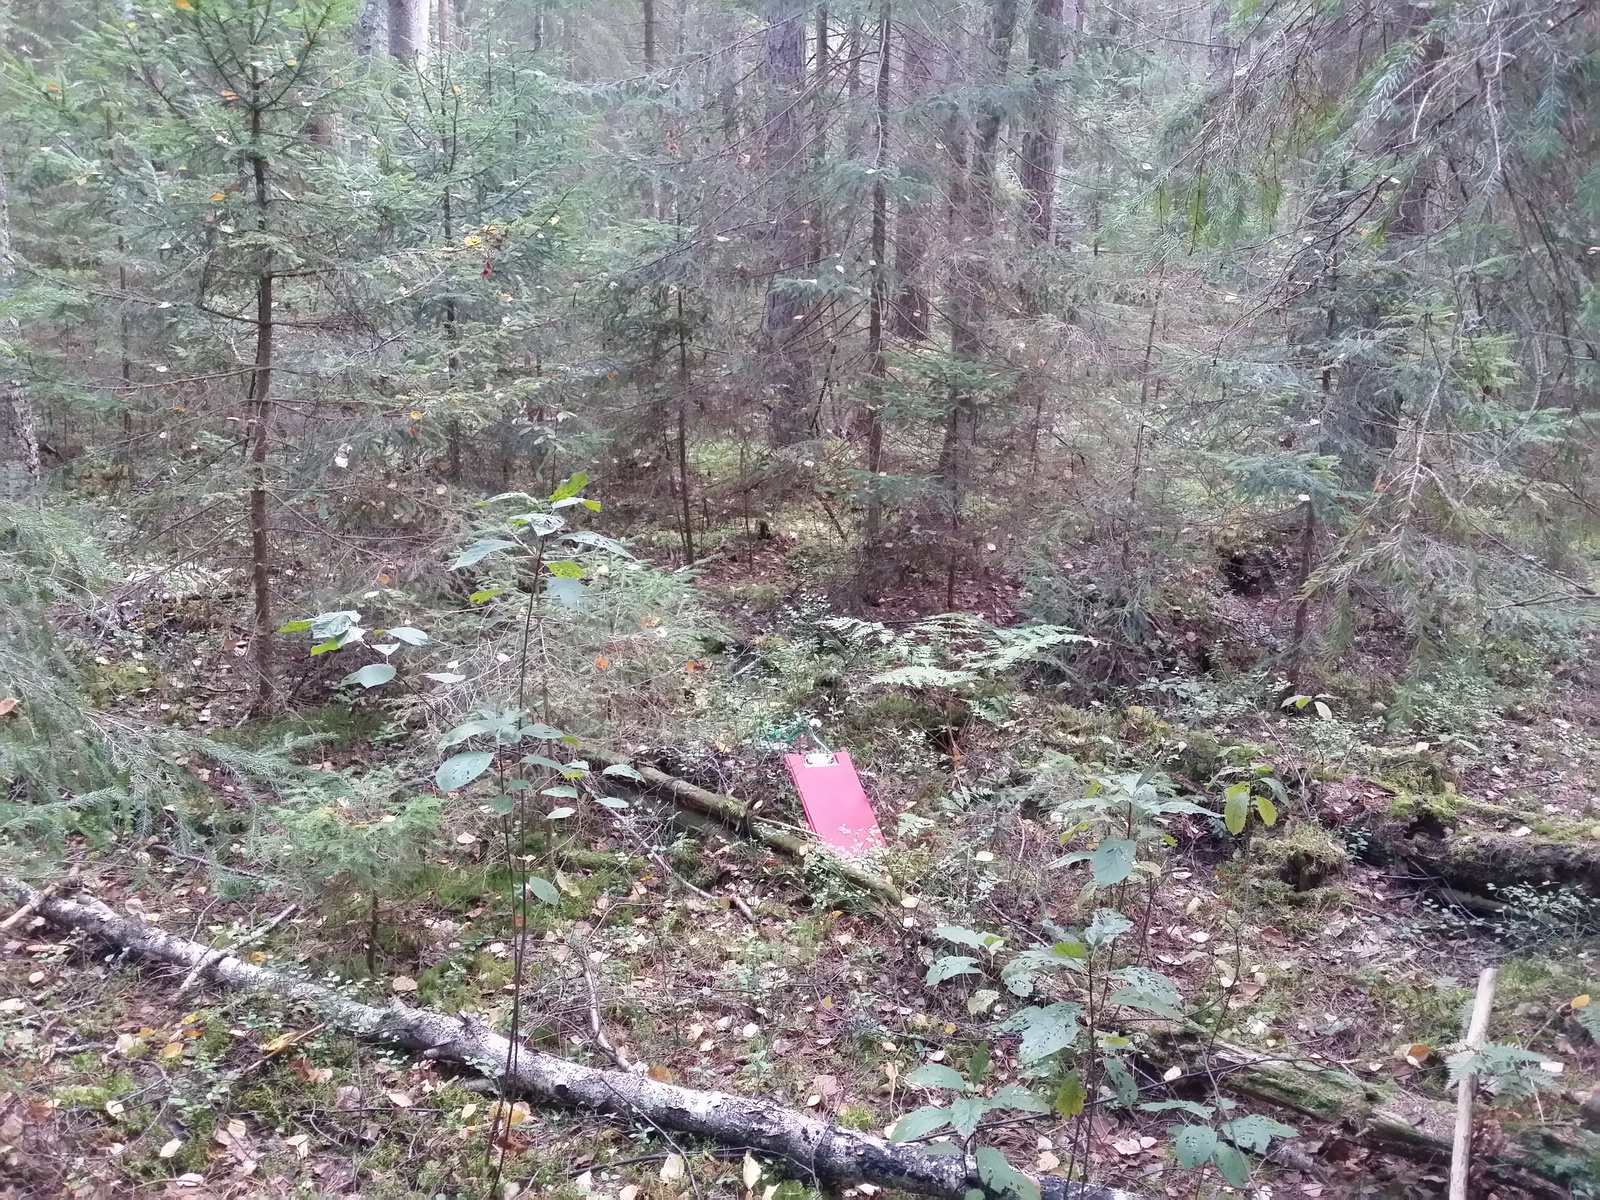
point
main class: Woodland
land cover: Spruce dominated coniferous woodland
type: hemiboreal forest and nemoral coniferous forest and mixed broadleaved-coniferous forest
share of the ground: > 75 %
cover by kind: coniferous forest trees 65 %, broadleaved forest trees 20 %, lichens and mosses 15 %
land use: Forestry
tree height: > 5 m
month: September
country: LV
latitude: 57.1558
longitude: 27.5868
